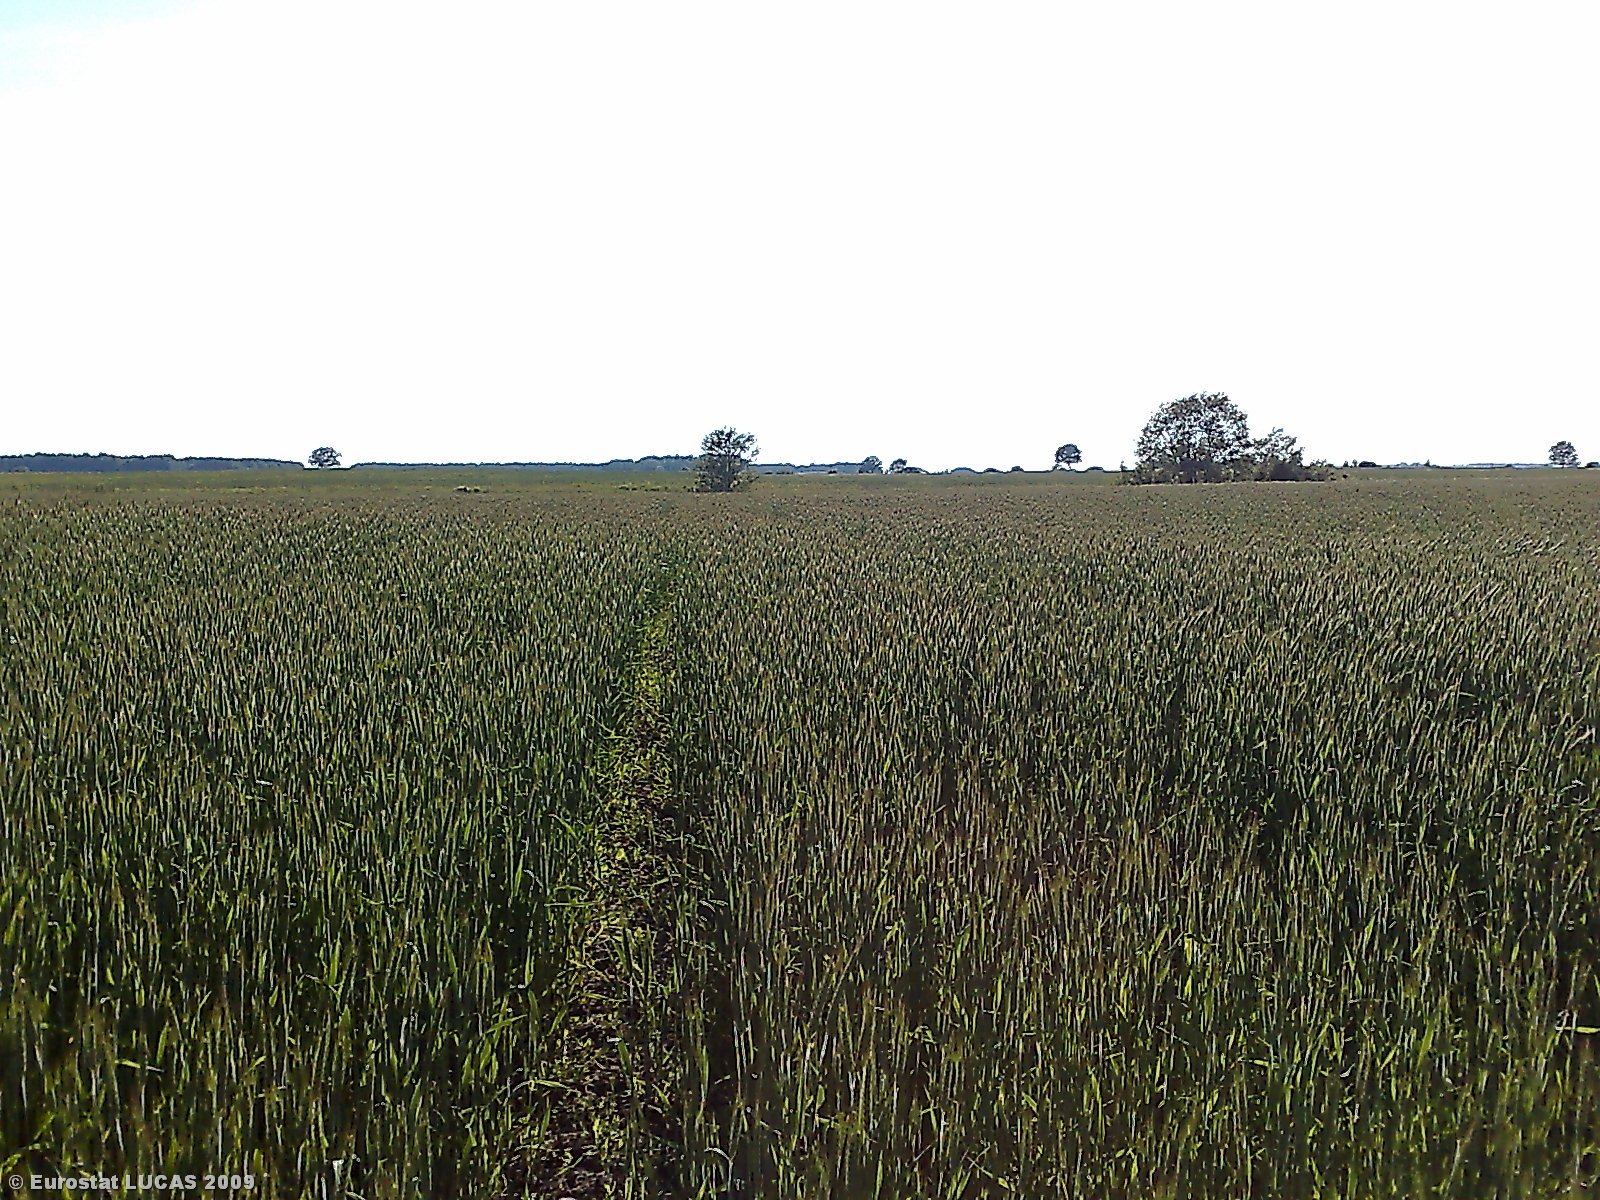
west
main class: Cropland
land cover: Rye
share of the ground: > 75 %
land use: Agriculture (excluding fallow land and kitchen gardens)
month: June
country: LT
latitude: 56.1698
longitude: 23.9524
